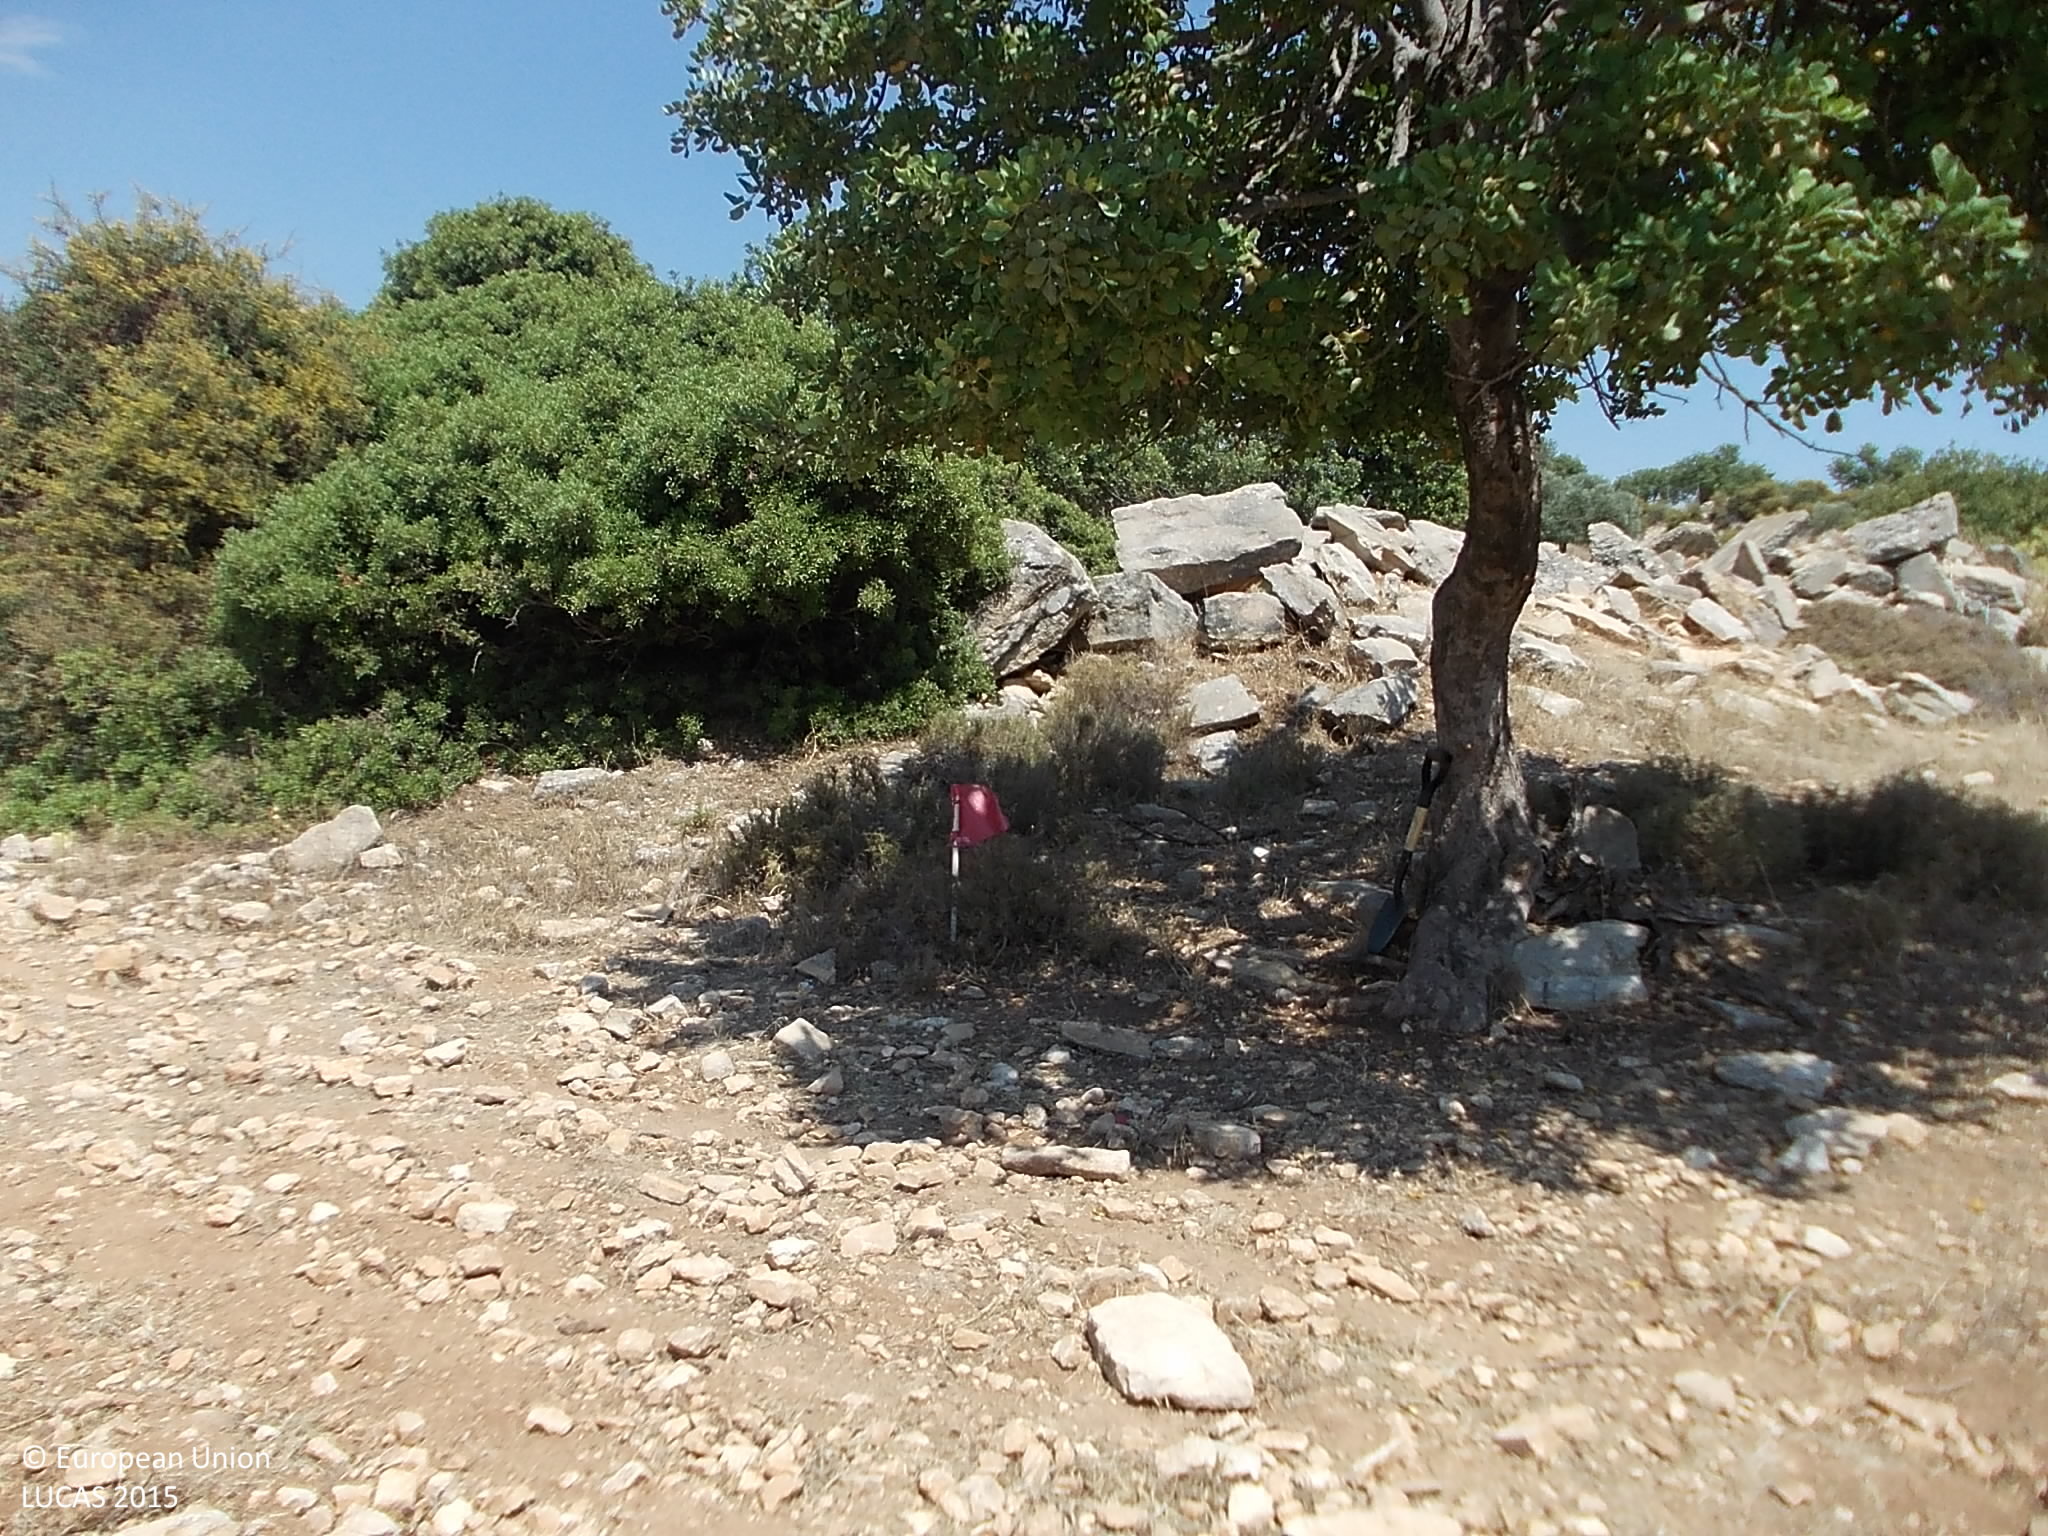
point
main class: Cropland
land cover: Nuts trees
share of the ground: 10 - 25 %
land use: Agriculture (excluding fallow land and kitchen gardens)
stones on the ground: 25 - 50 %
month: July
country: CY
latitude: 34.7491
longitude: 32.7342
